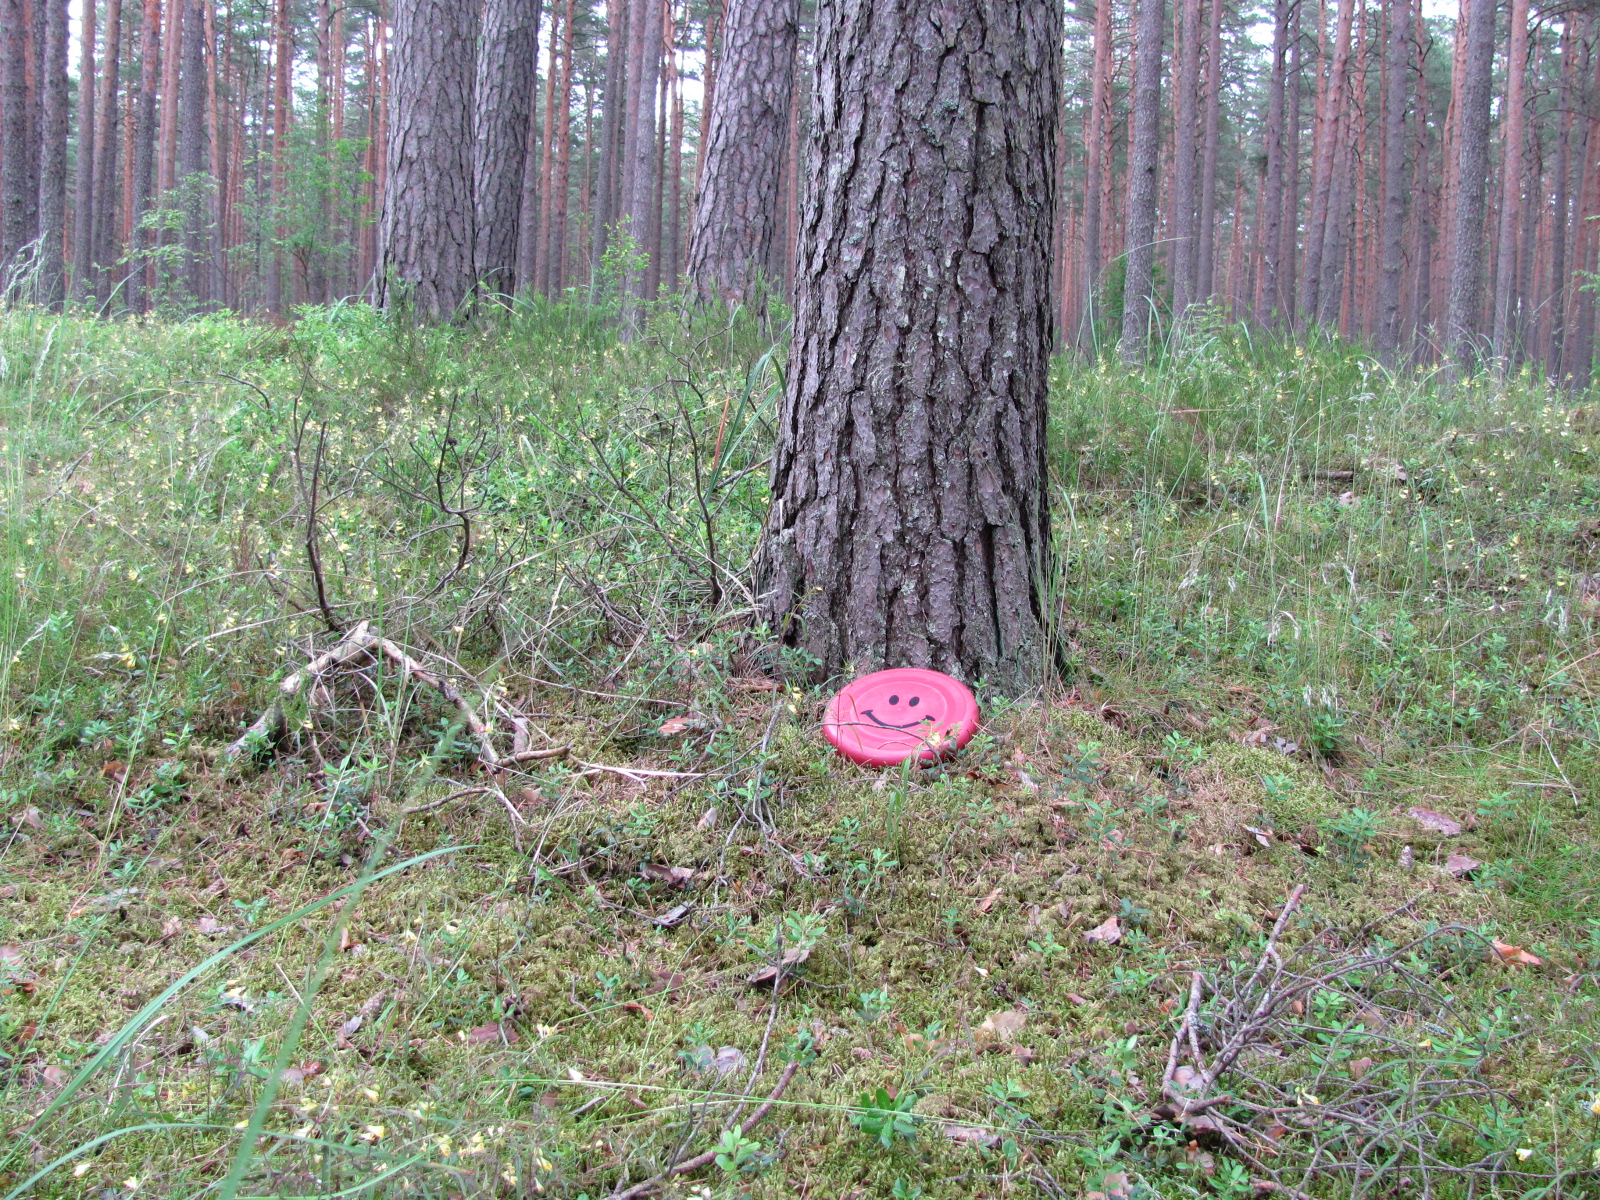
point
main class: Woodland
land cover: Pine dominated coniferous woodland
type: hemiboreal forest and nemoral coniferous forest and mixed broadleaved-coniferous forest
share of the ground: > 75 %
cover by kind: coniferous forest trees 80 %, herbaceous plants 10 %, lichens and mosses 10 %
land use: Forestry
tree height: > 5 m
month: June
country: LV
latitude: 56.9219
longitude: 23.9308
